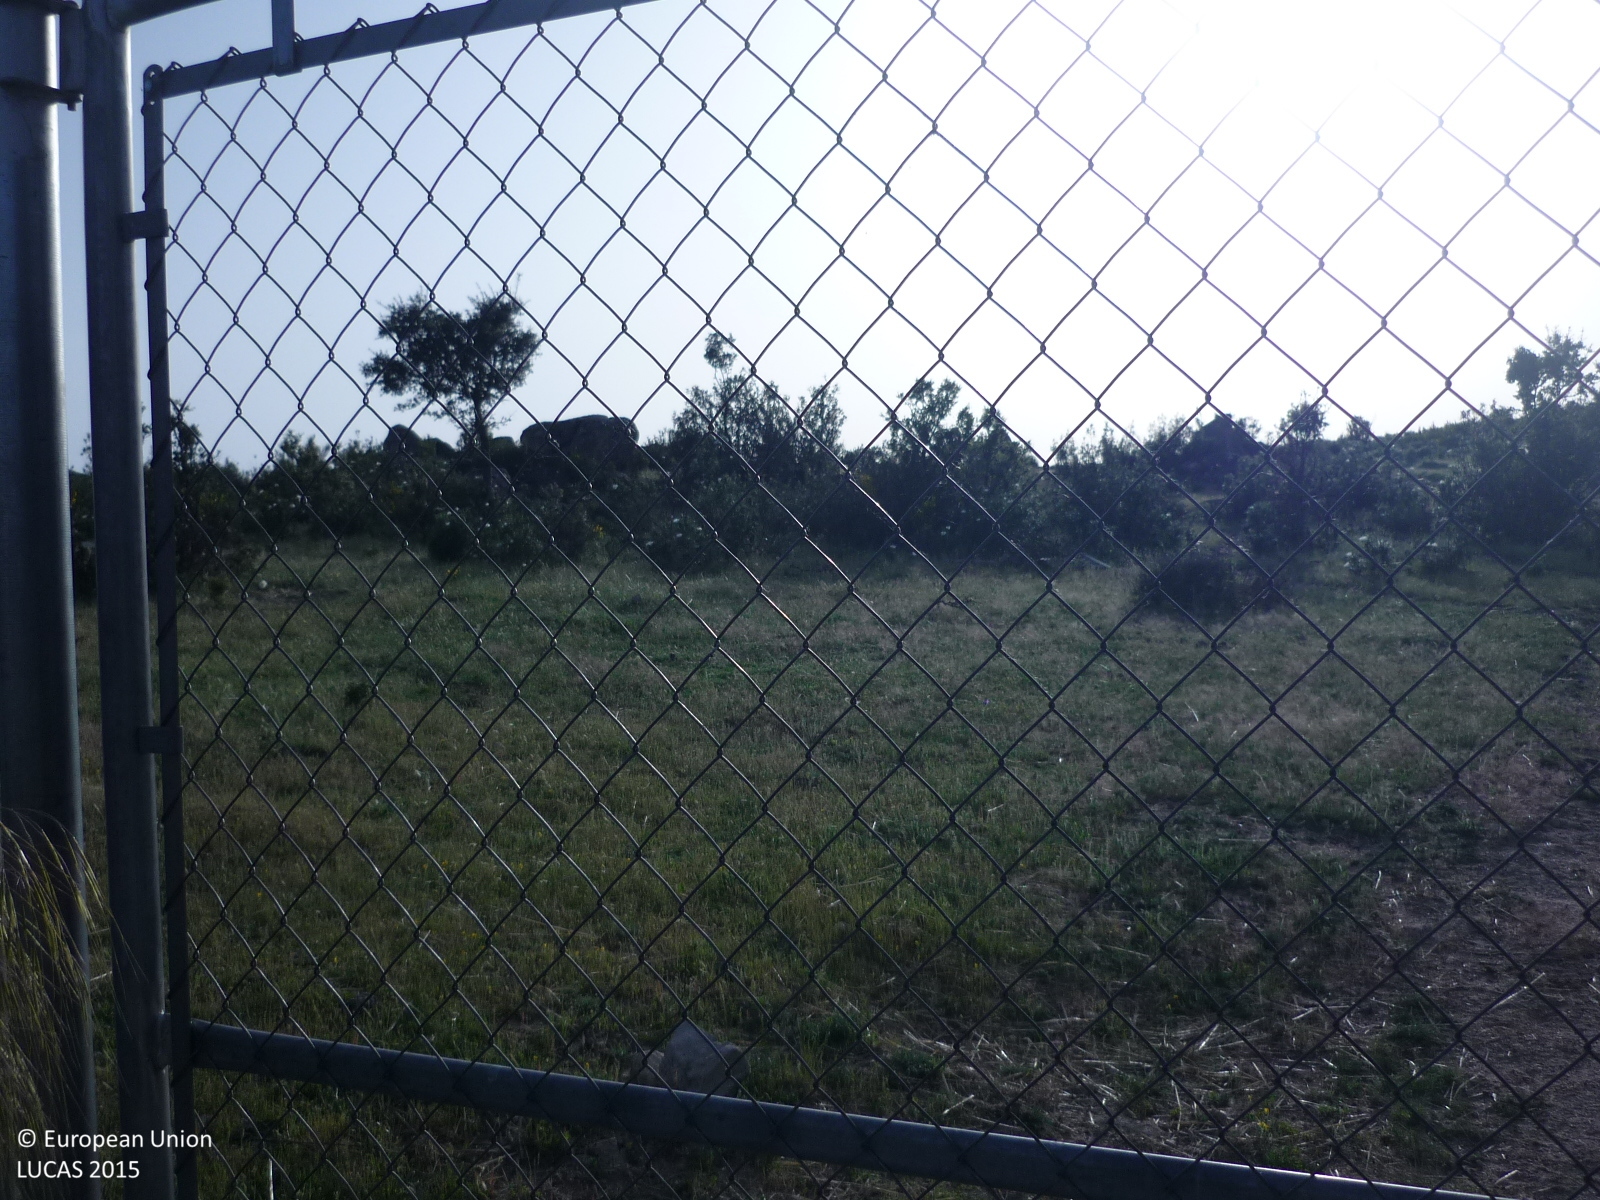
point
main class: Grassland
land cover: Grassland with sparse tree/shrub cover
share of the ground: > 75 %
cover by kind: herbaceous plants 85 %, shrubs 10 %, broadleaved forest trees 5 %
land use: Agriculture (excluding fallow land and kitchen gardens)
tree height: < 5 m
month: May
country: ES
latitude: 40.7224
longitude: -3.8837
